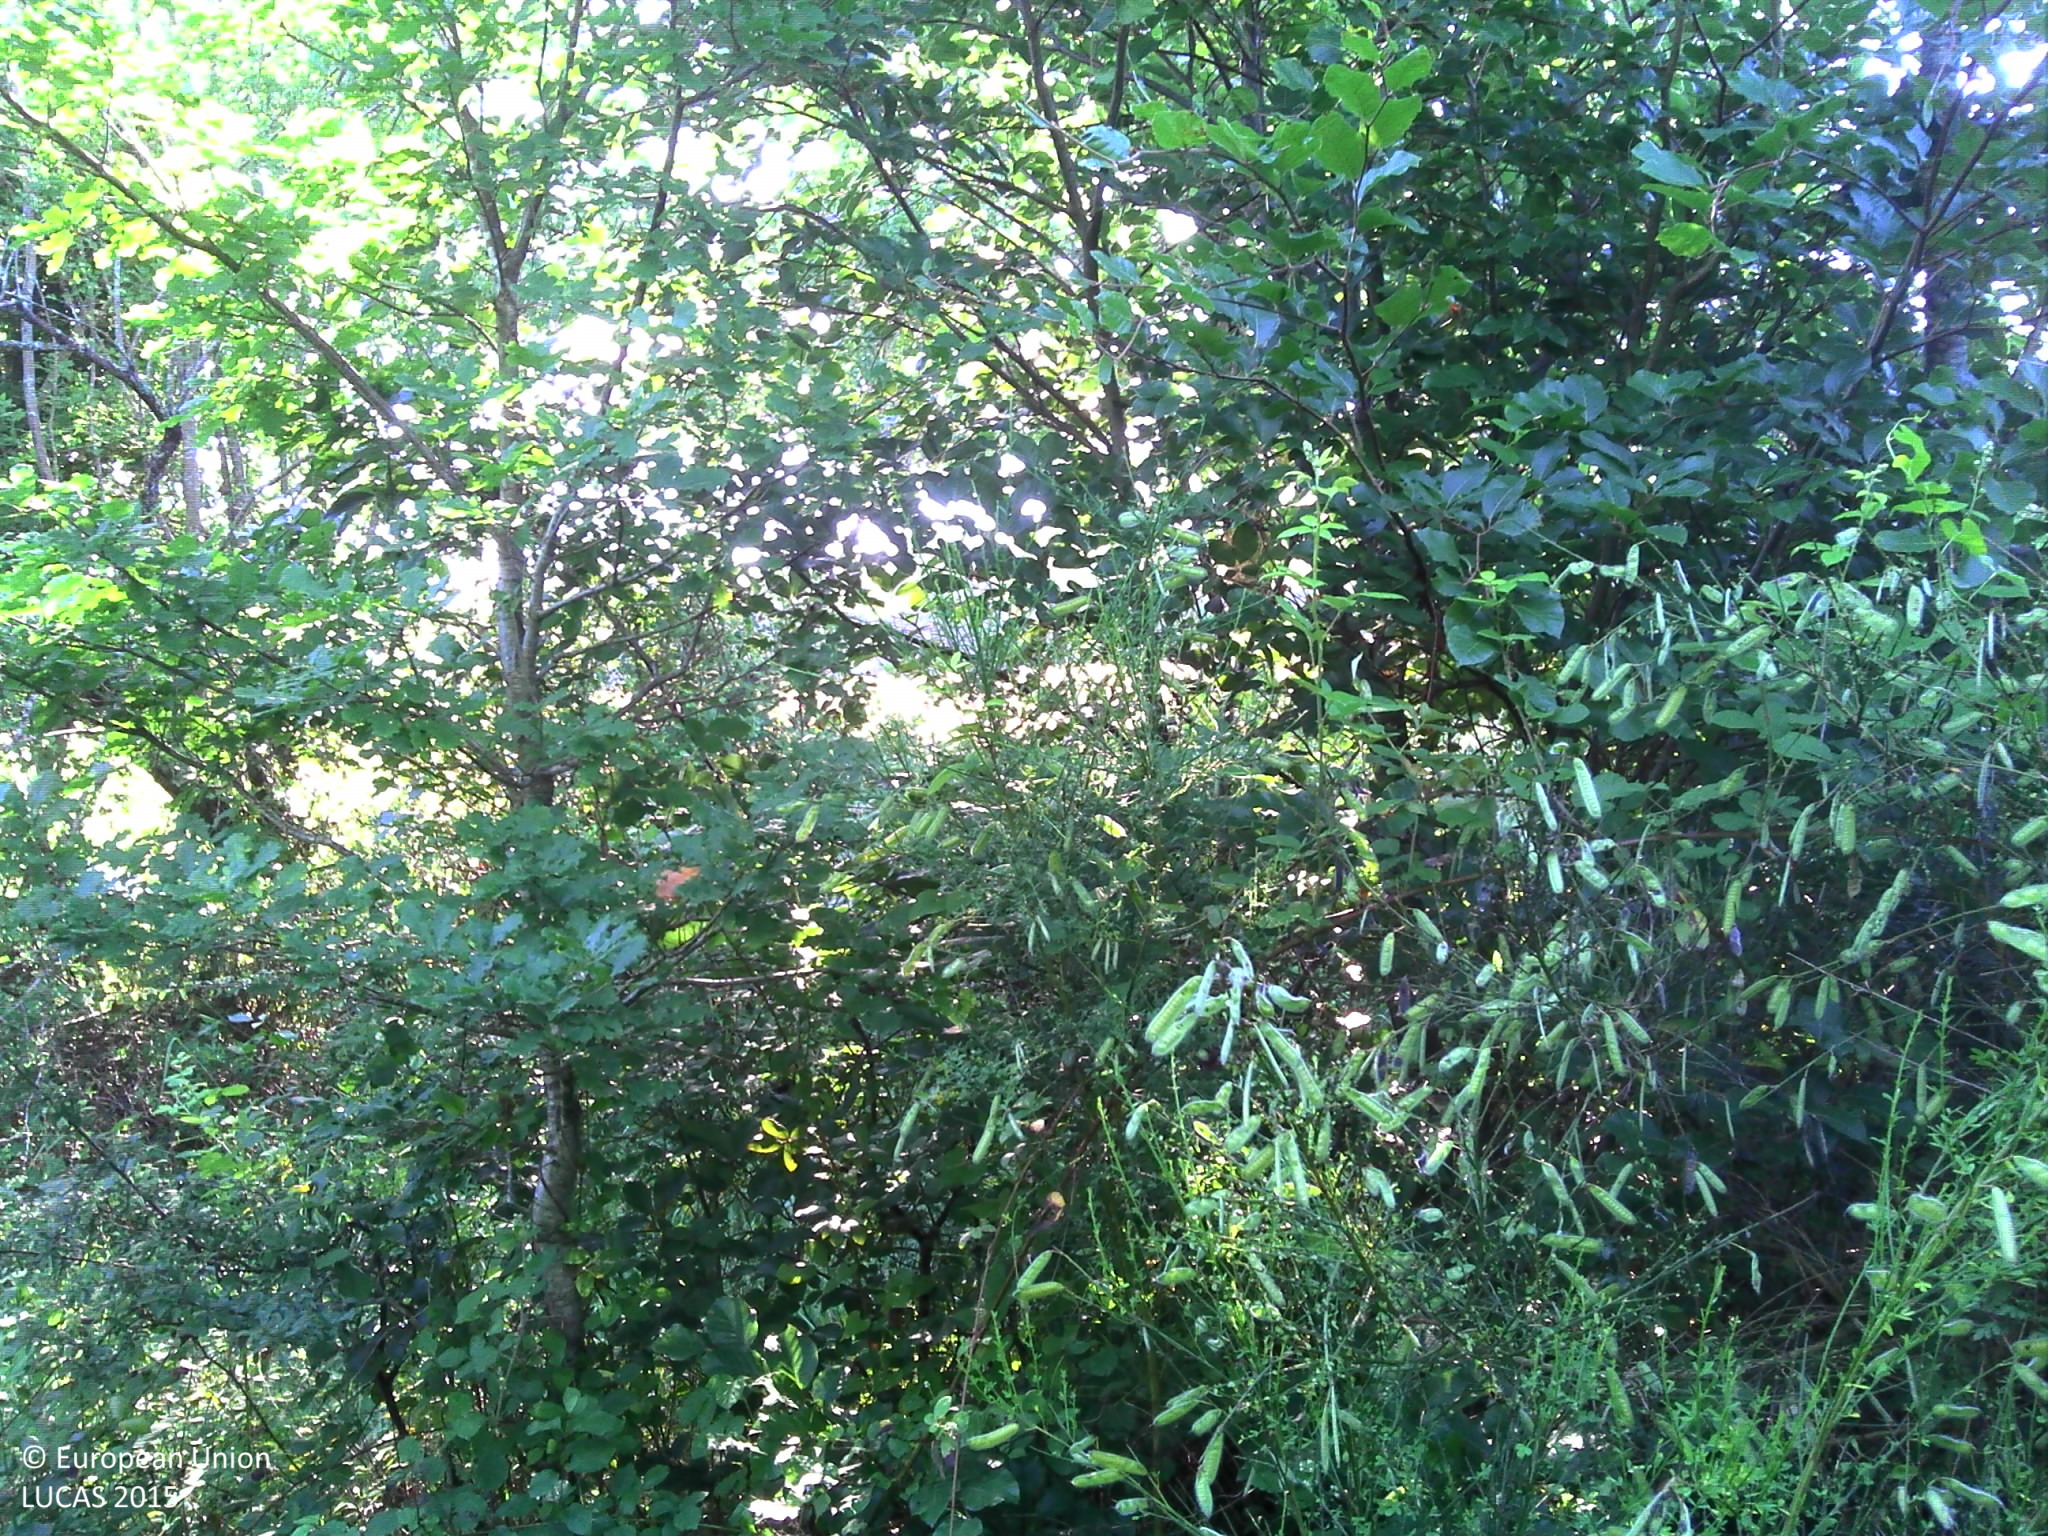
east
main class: Woodland
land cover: Broadleaved woodland
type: acidophilous oak and oak-birch forest
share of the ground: > 75 %
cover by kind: broadleaved forest trees 85 %, shrubs 10 %, herbaceous plants 5 %
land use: Semi-natural and natural areas not in use
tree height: > 5 m
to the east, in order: Broadleaved woodland; Tracks; Fences; Triticale; Fences; Lines of trees; Tracks; Broadleaved woodland
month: June
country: FR
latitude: 45.8809
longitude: 0.3852
